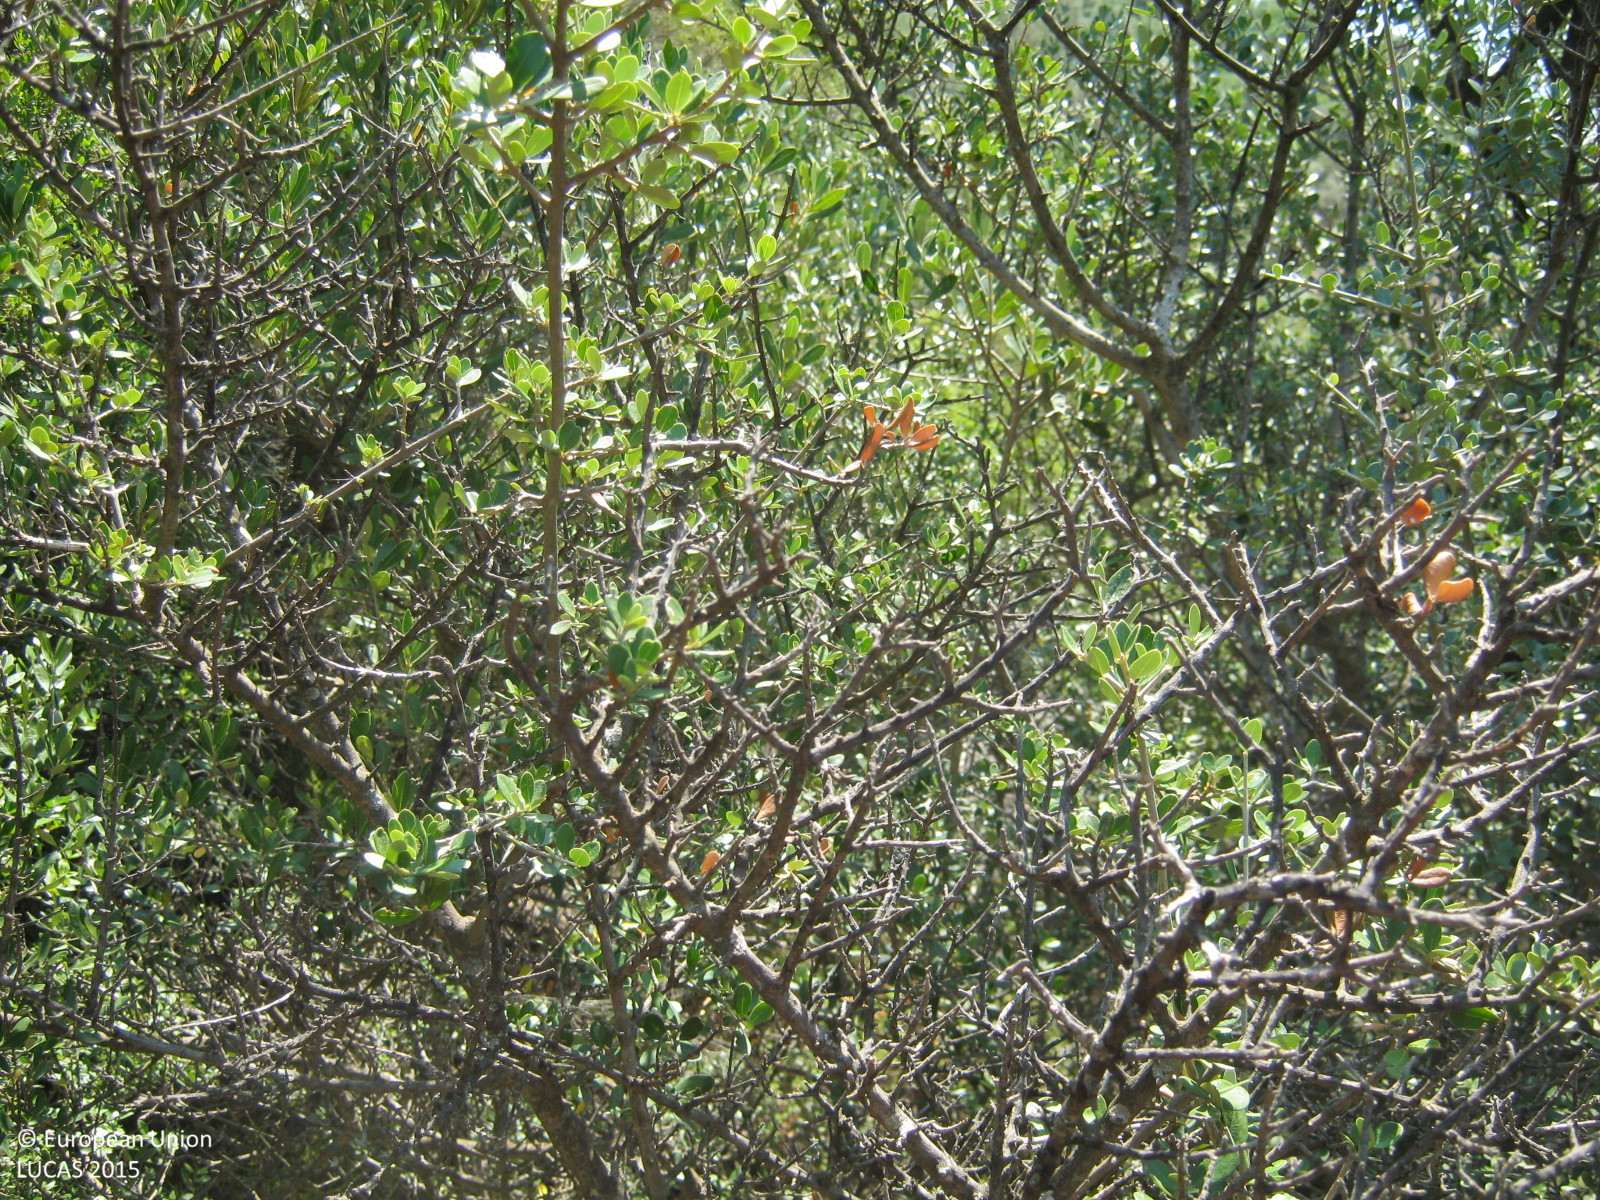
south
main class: Woodland
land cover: Broadleaved woodland
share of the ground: > 75 %
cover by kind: broadleaved forest trees 80 %, unconsolidated bare surface 10 %, shrubs 5 %, herbaceous plants 5 %
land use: Semi-natural and natural areas not in use
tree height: < 5 m
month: July
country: GR
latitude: 35.4331
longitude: 23.7847
